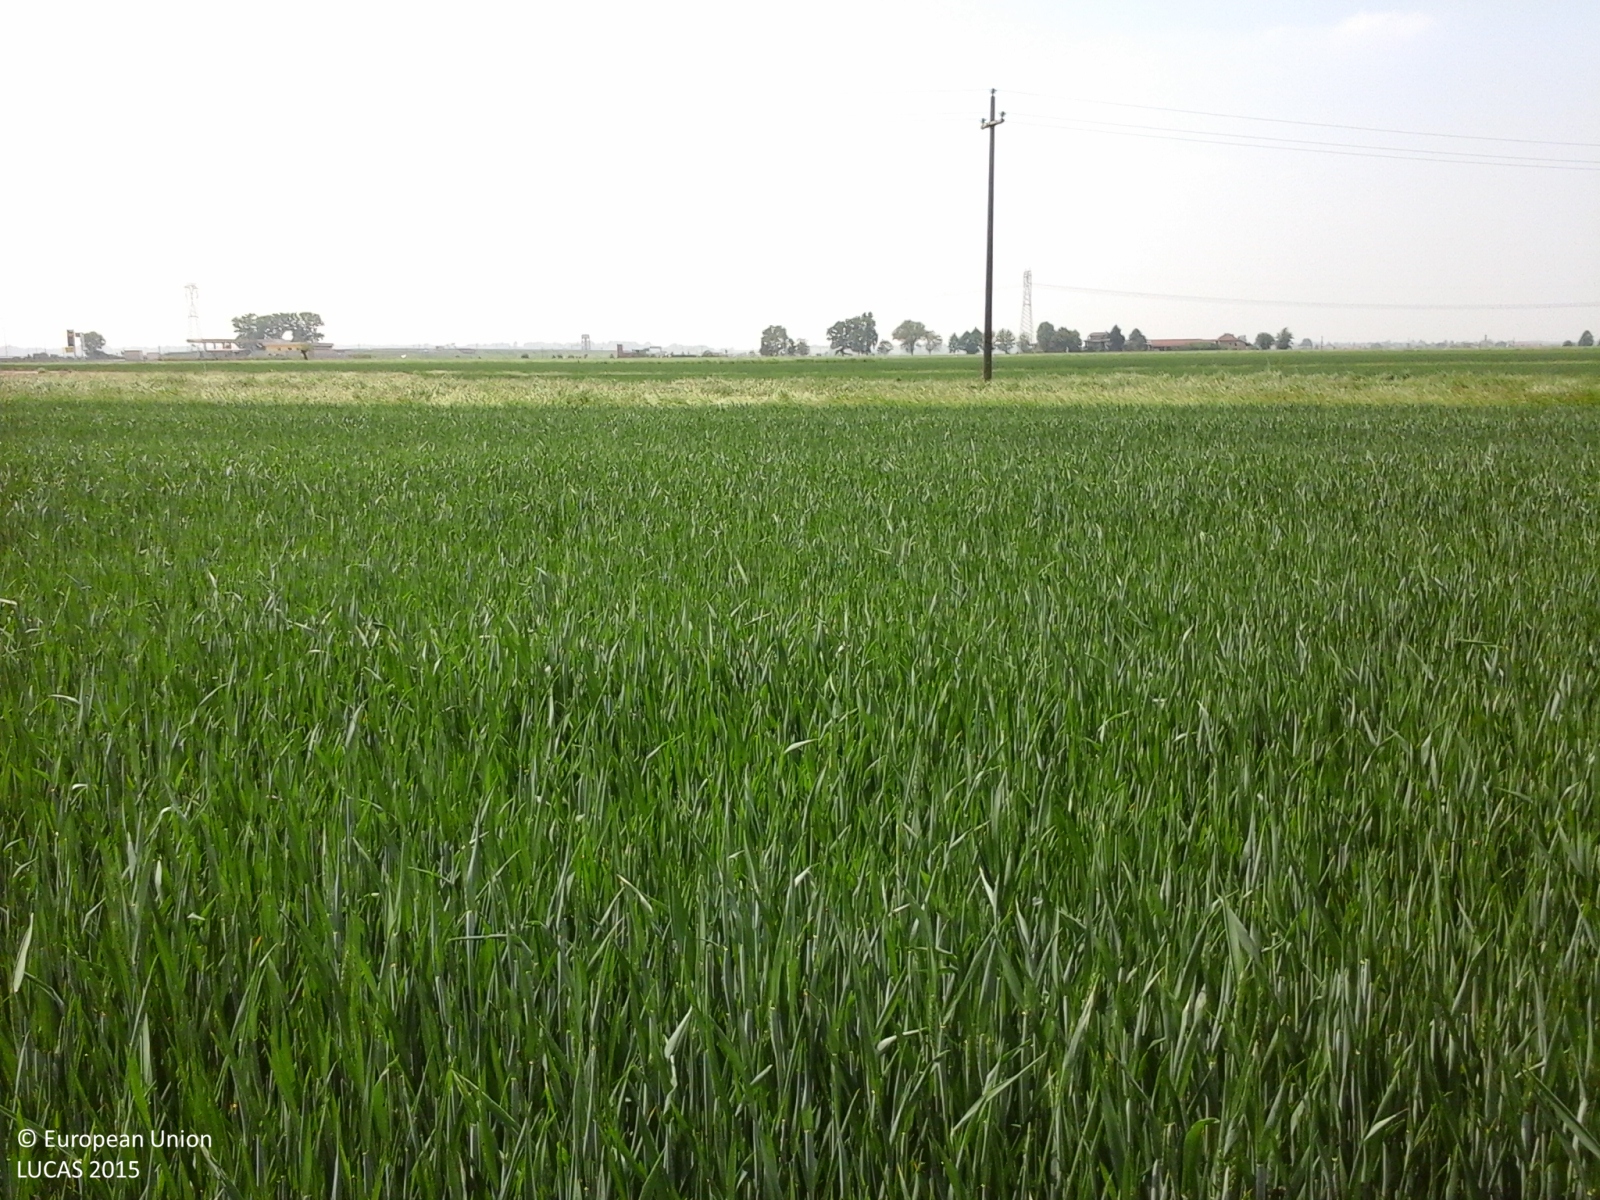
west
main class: Cropland
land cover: Common wheat
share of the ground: > 75 %
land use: Agriculture (excluding fallow land and kitchen gardens)
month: May
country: IT
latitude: 44.6705
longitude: 7.8221
